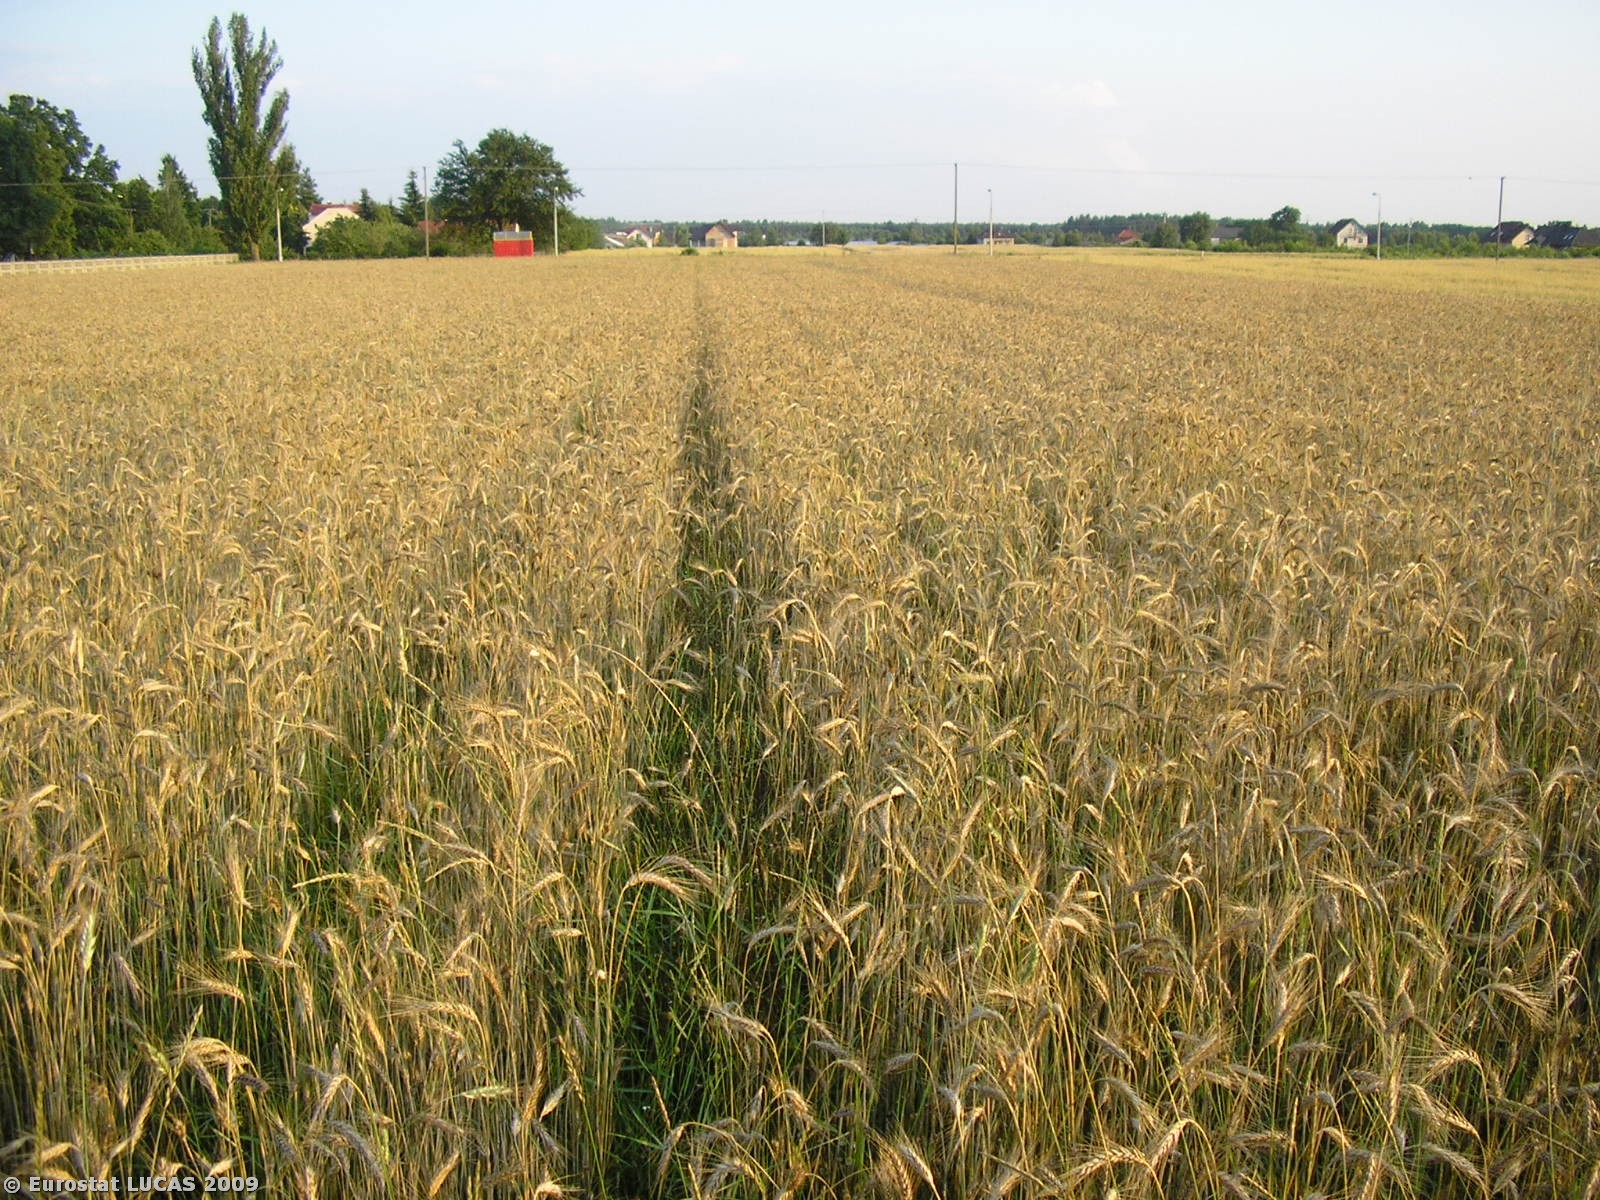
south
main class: Cropland
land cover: Triticale
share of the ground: > 75 %
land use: Agriculture (excluding fallow land and kitchen gardens)
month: July
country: PL
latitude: 52.4557
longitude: 20.8885
